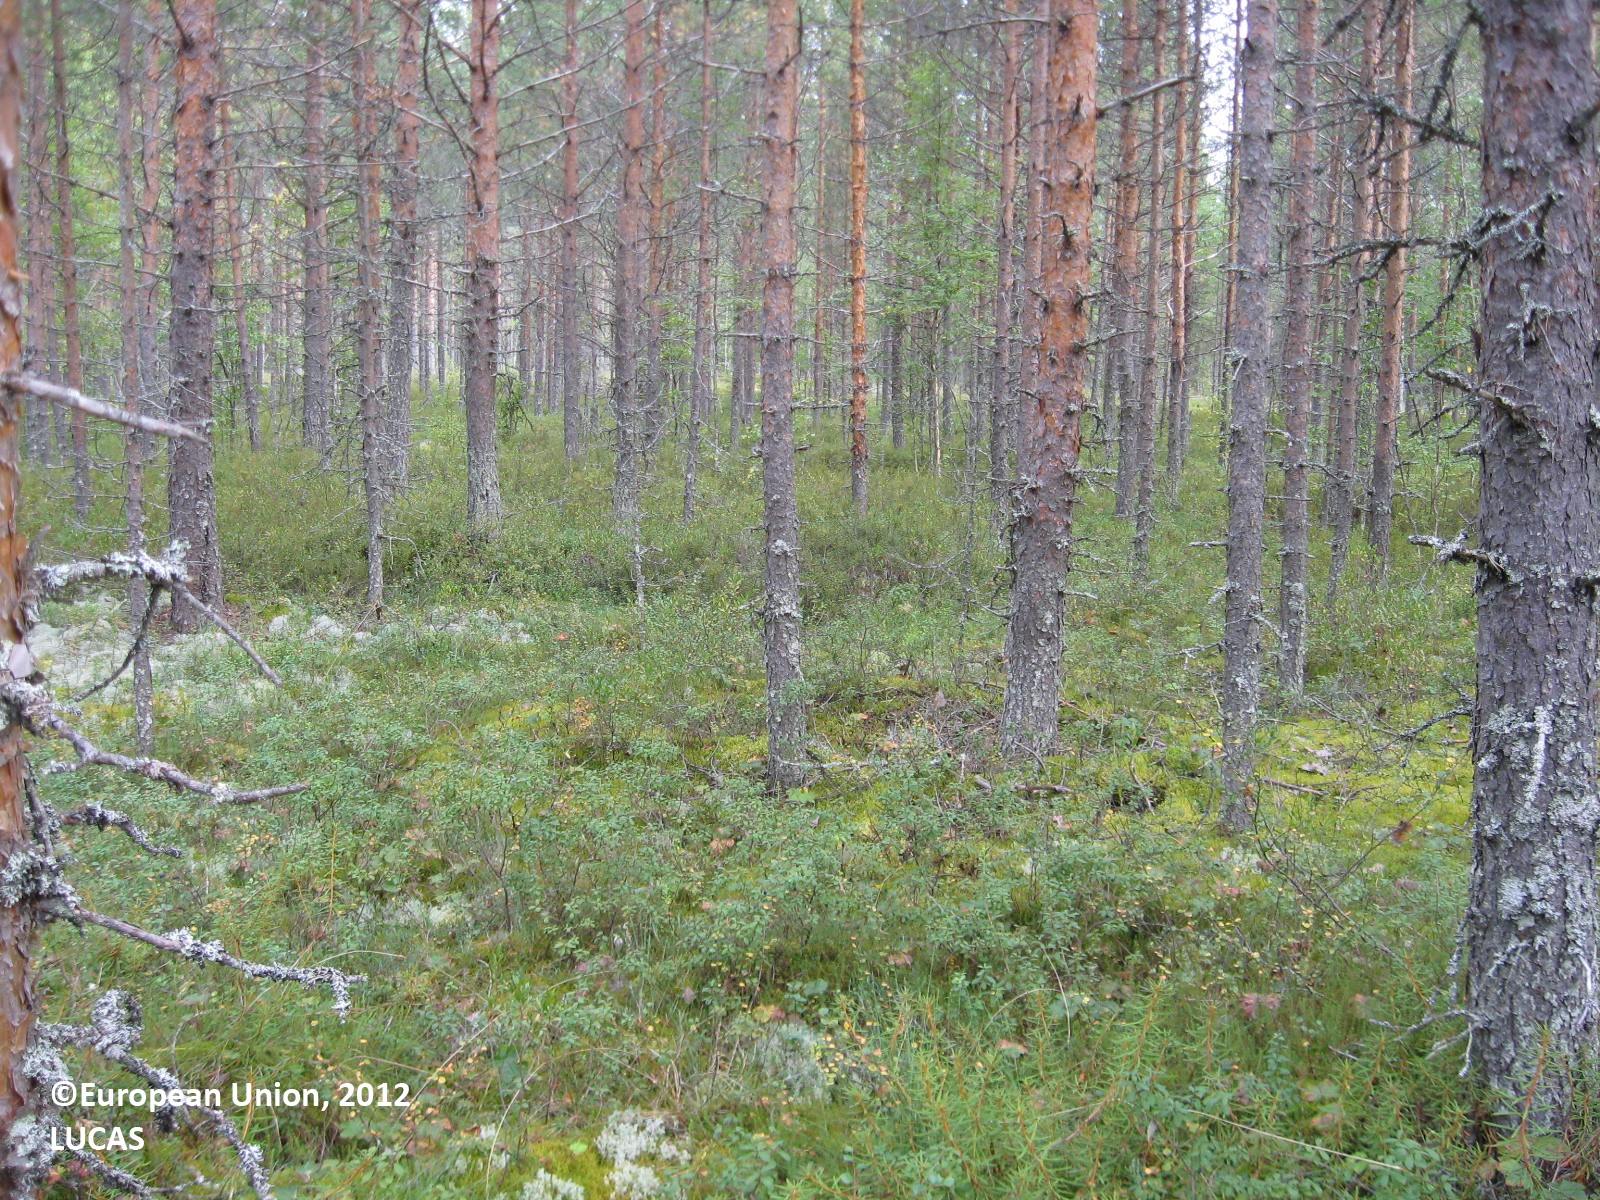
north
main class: Woodland
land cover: Pine dominated coniferous woodland
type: boreal forest
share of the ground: > 75 %
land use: Forestry
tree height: > 5 m
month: August
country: FI
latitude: 63.4472
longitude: 30.0824
